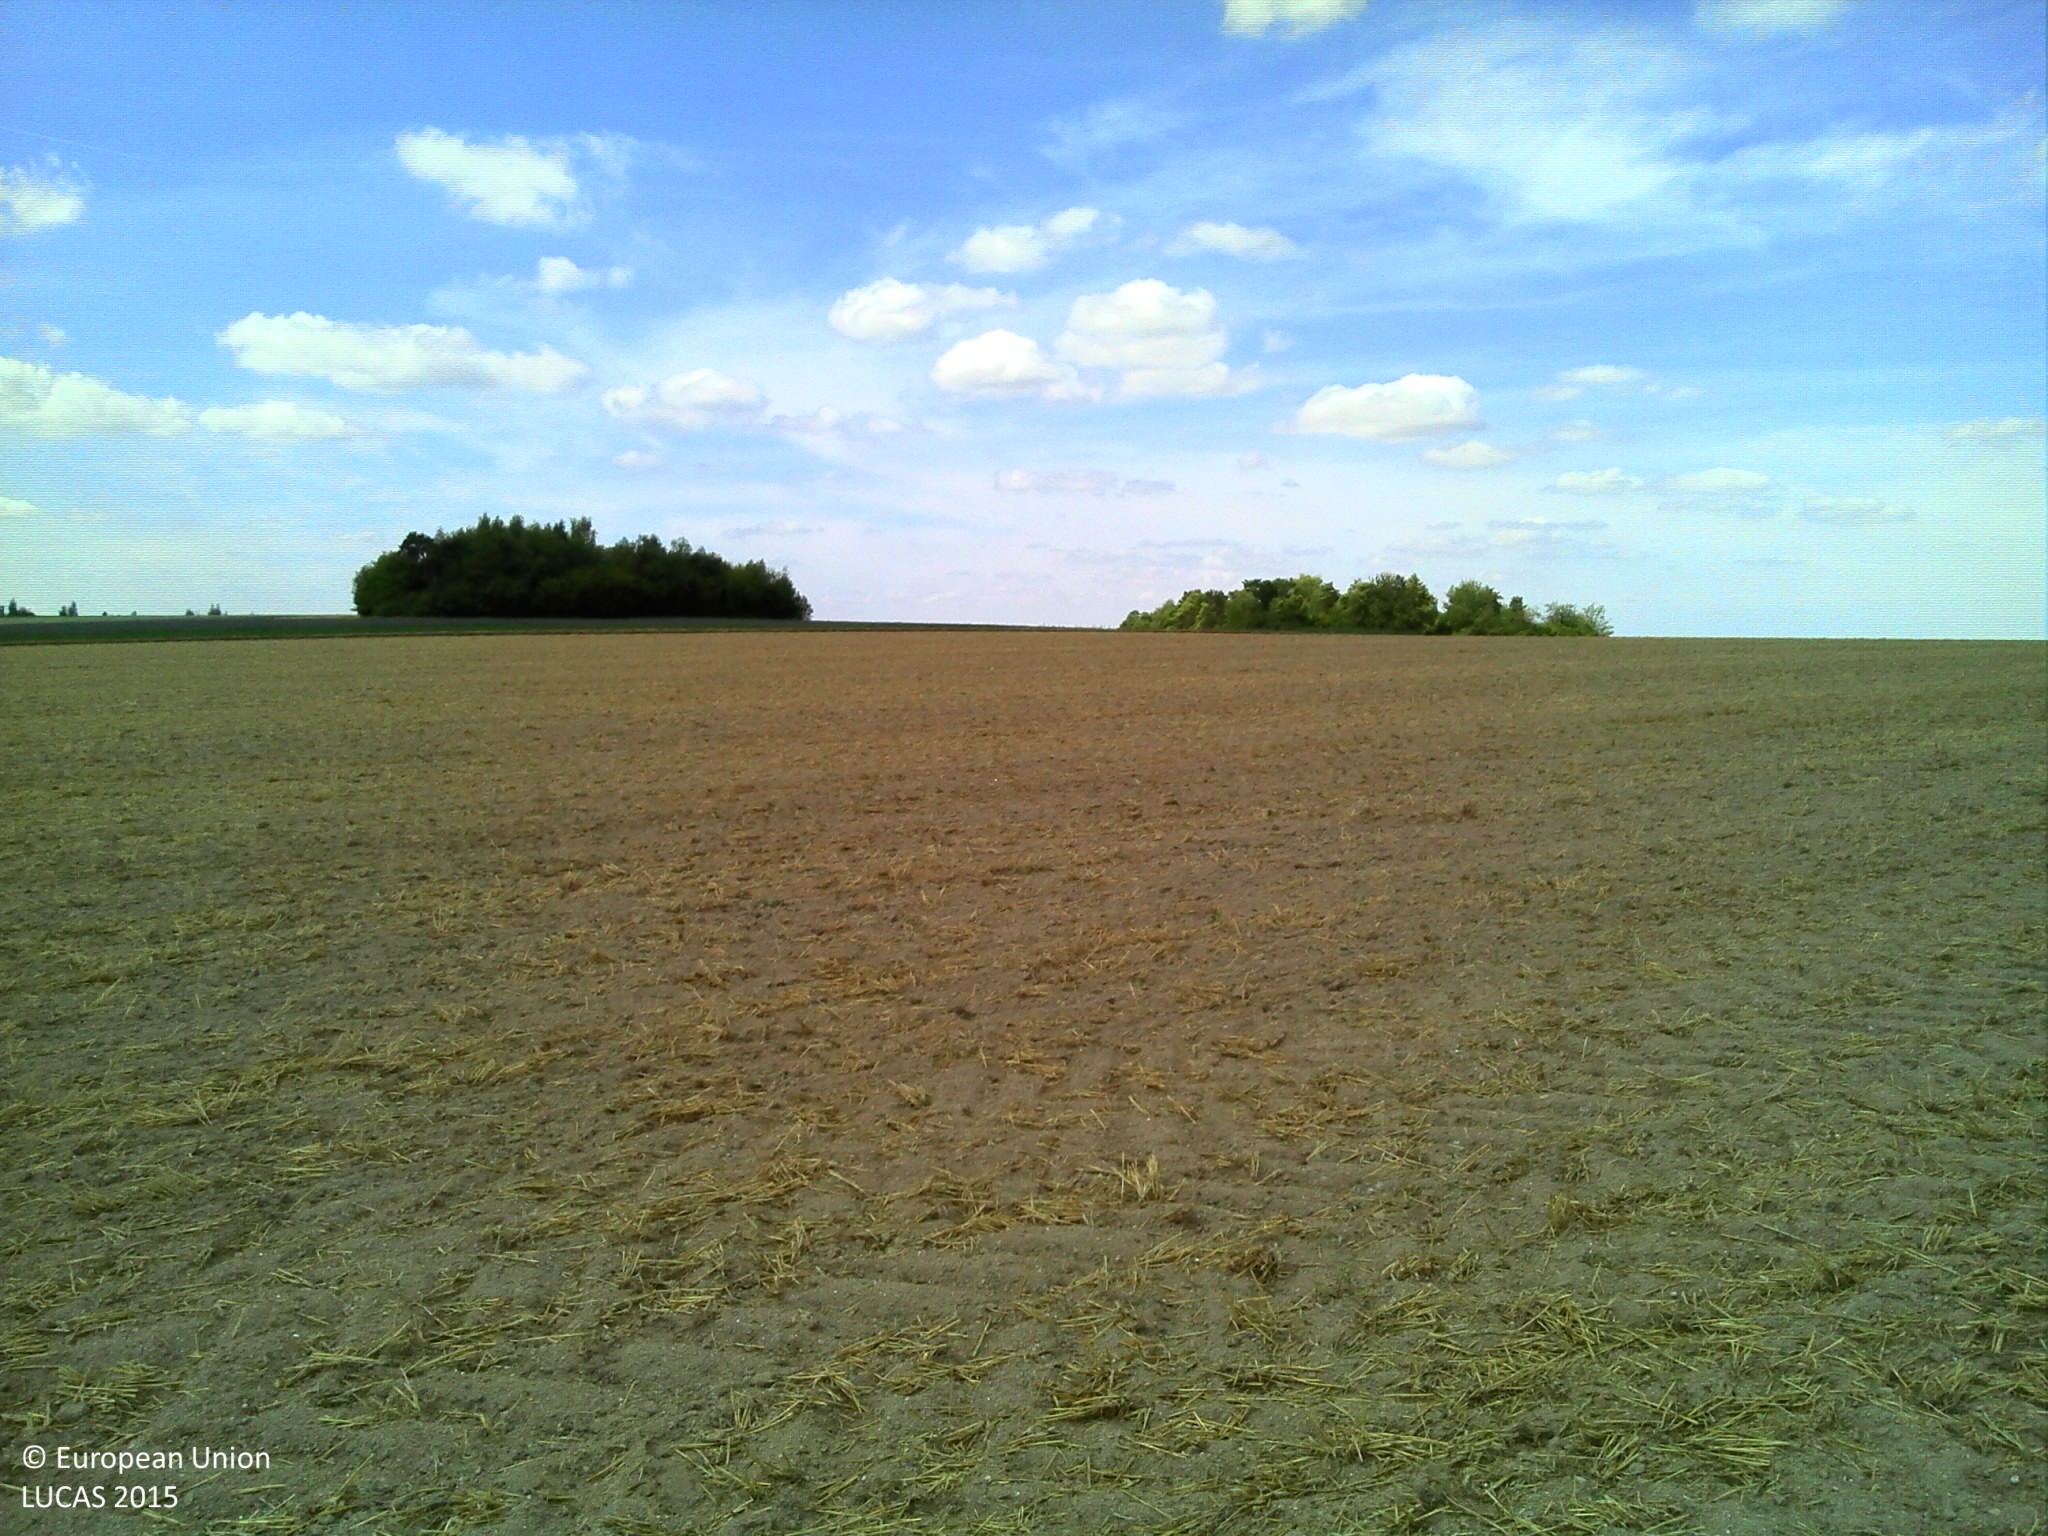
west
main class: Cropland
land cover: Barley
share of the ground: > 75 %
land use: Agriculture (excluding fallow land and kitchen gardens)
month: August
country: FR
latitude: 49.1764
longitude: 4.3032
